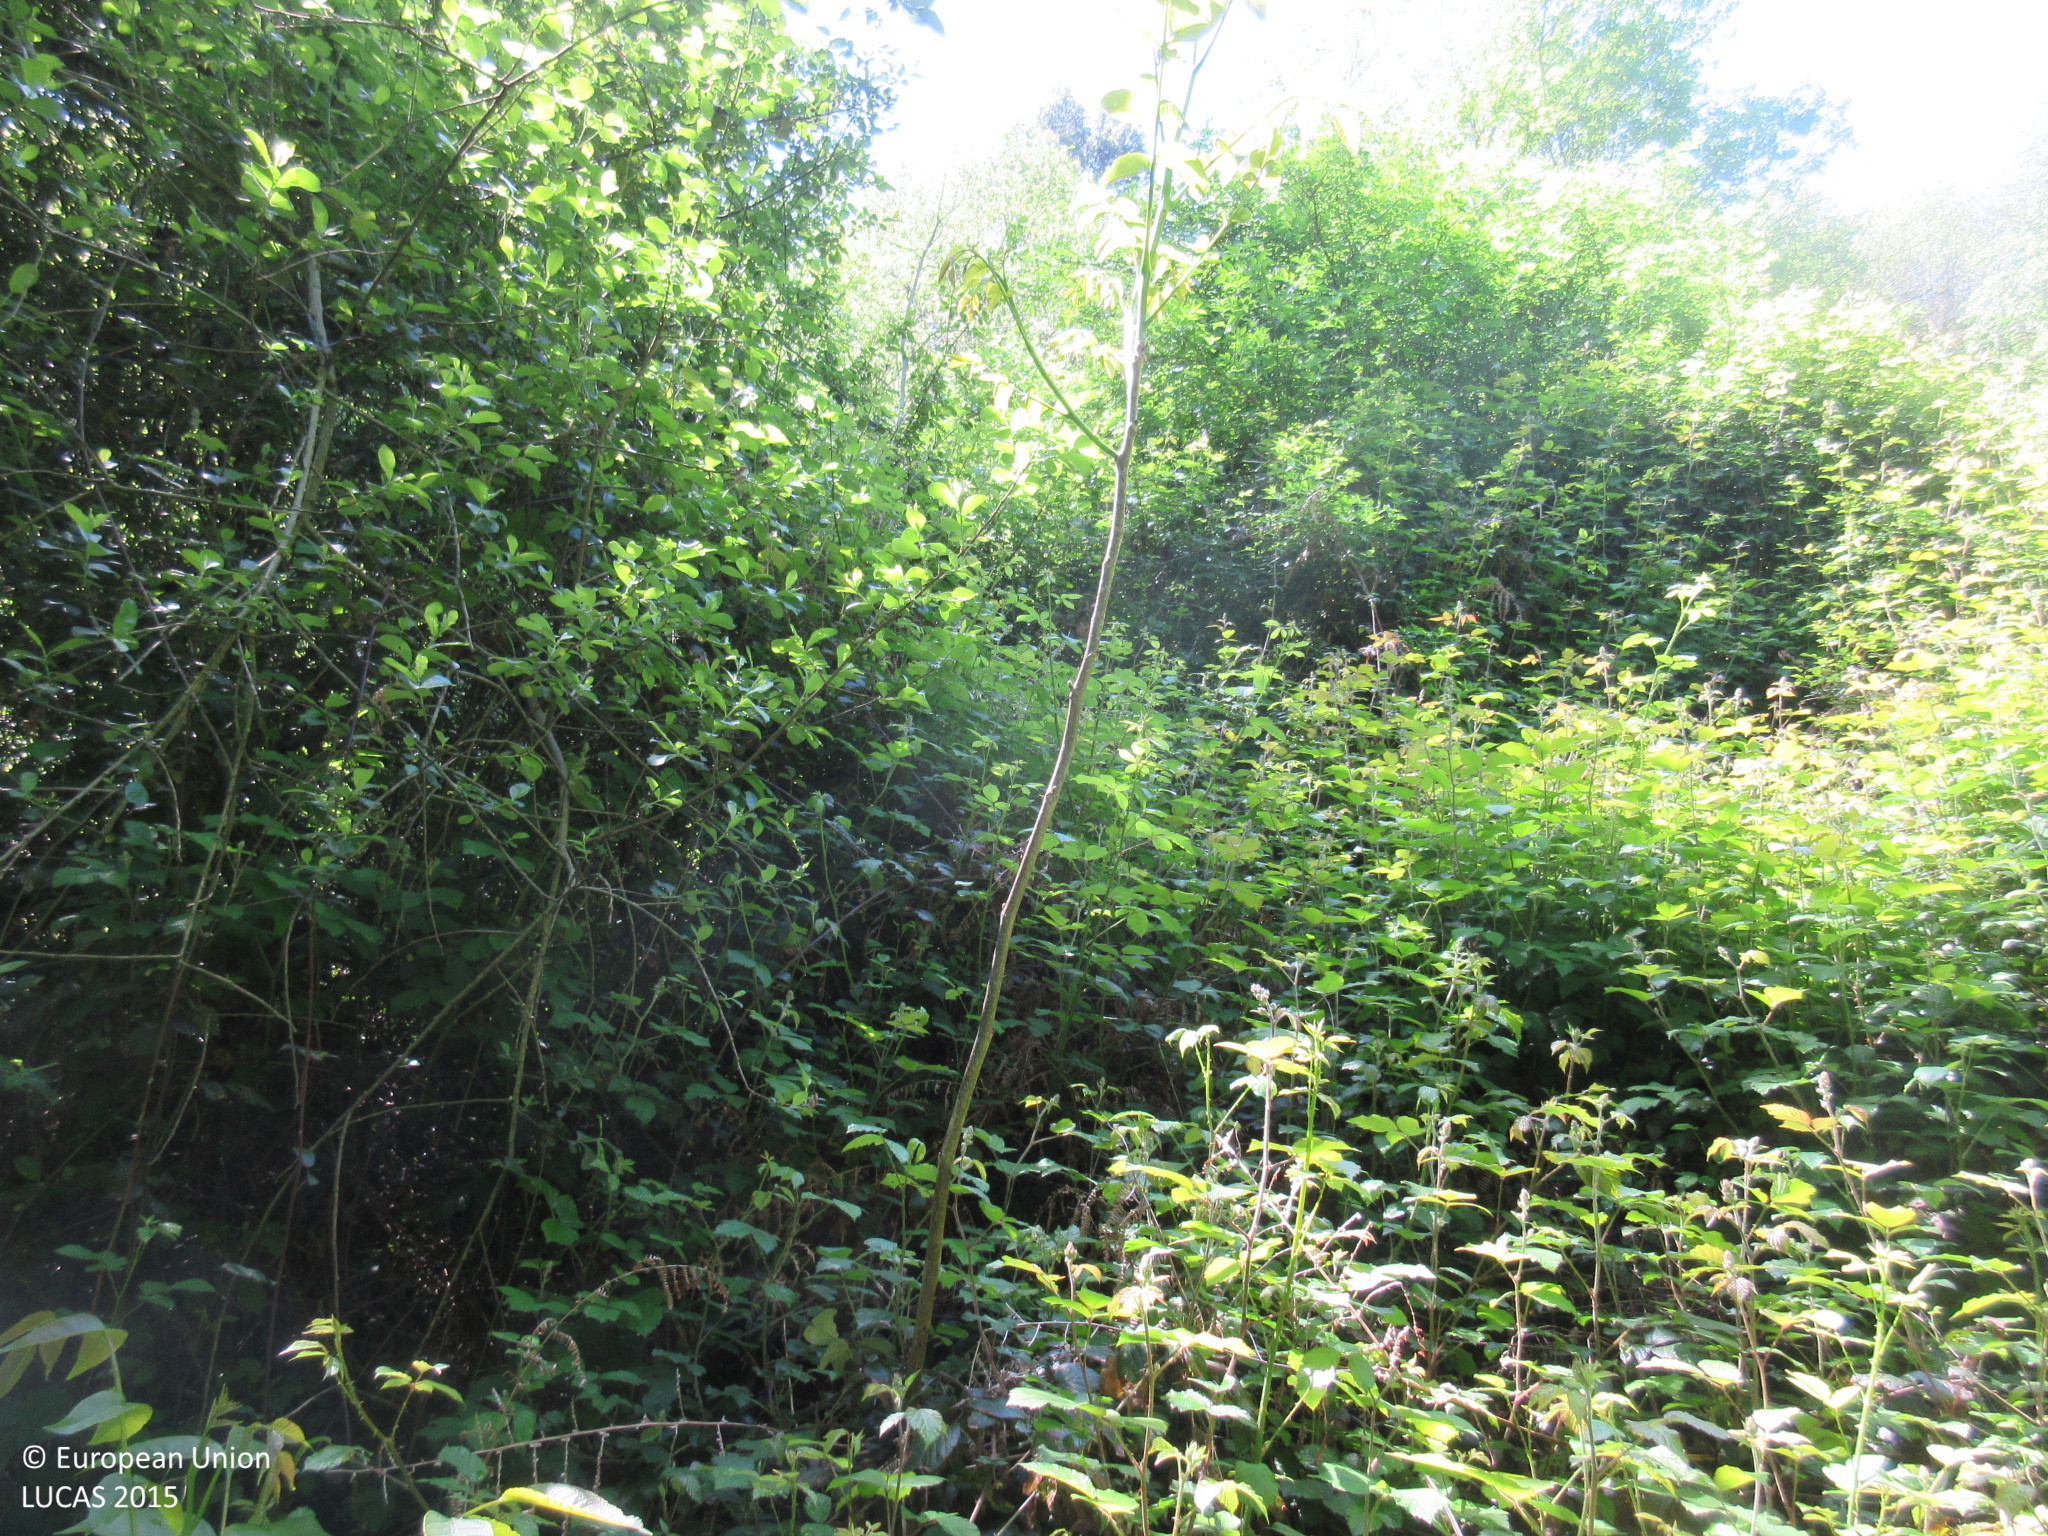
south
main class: Woodland
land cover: Broadleaved woodland
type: acidophilous oak and oak-birch forest
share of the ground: > 75 %
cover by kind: broadleaved forest trees 100 %
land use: Forestry
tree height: > 5 m
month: May
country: ES
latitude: 43.3134
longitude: -5.8064
